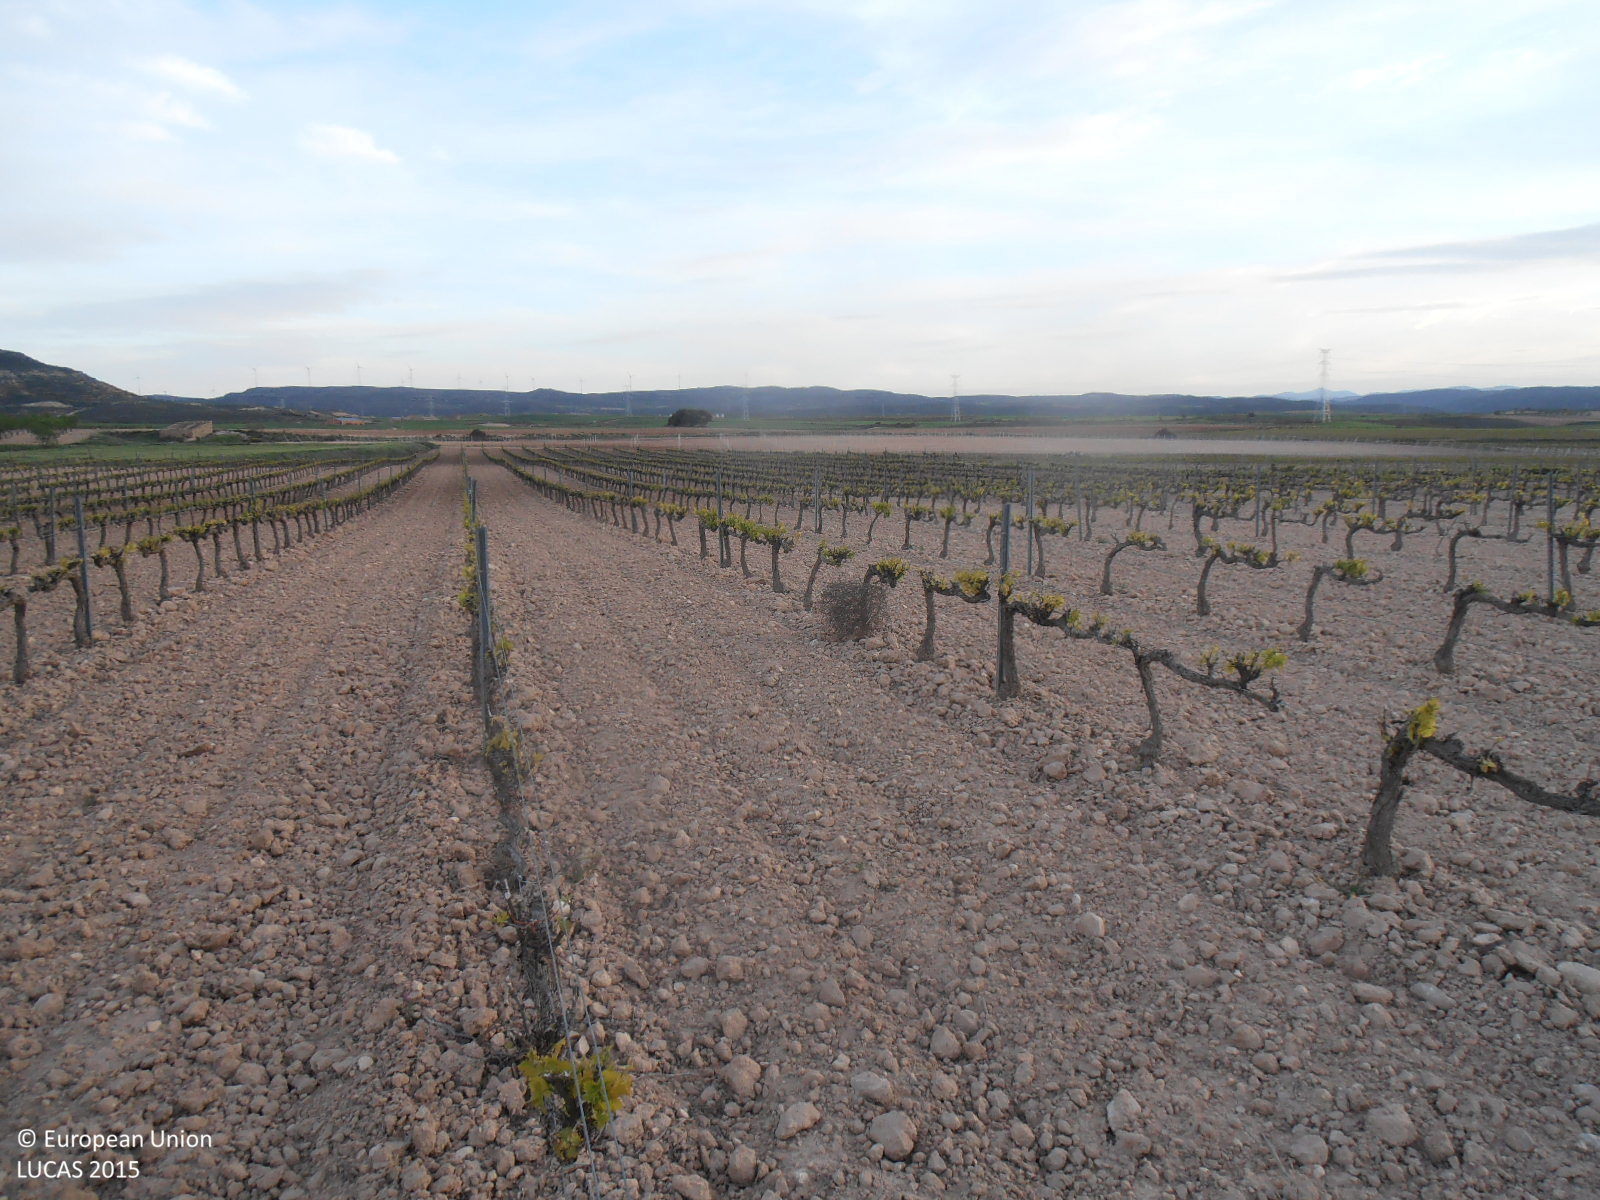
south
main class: Cropland
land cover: Vineyards
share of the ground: 10 - 25 %
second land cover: Other bare soil
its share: > 75 %
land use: Agriculture (excluding fallow land and kitchen gardens)
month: April
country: ES
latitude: 41.3602
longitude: -1.0056
